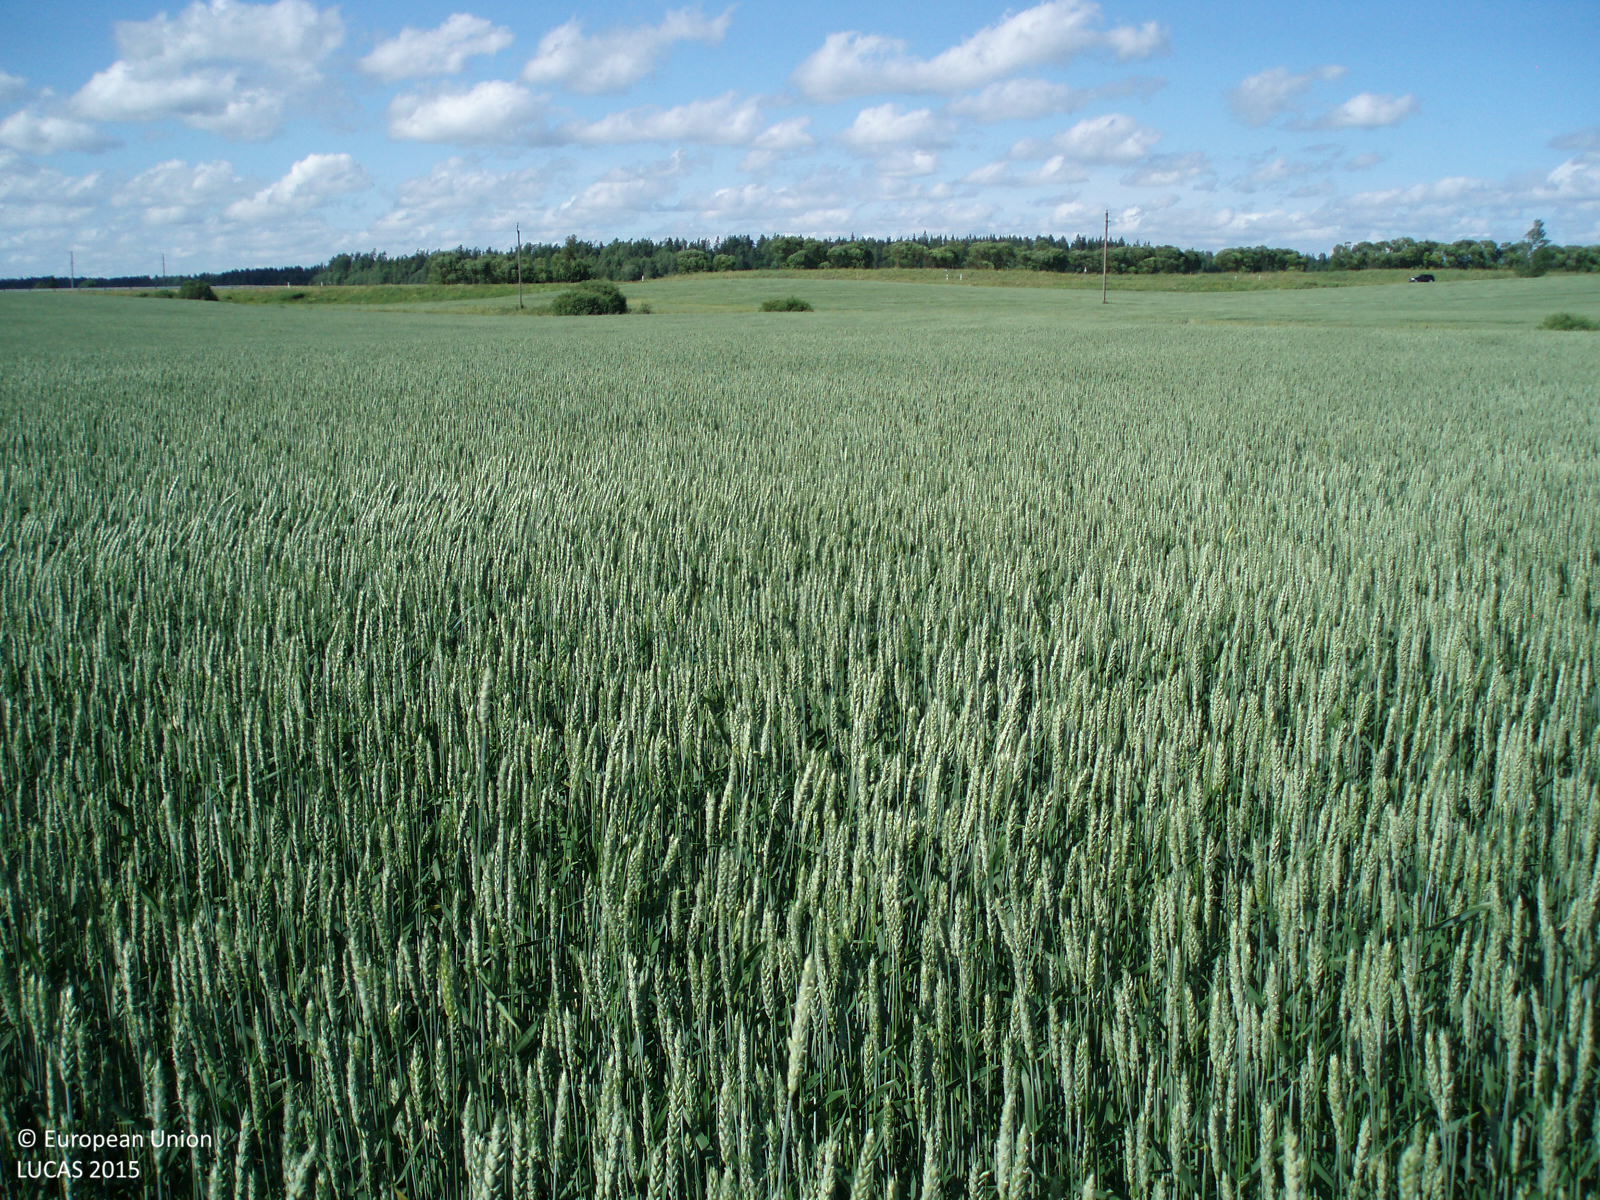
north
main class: Cropland
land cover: Common wheat
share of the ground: > 75 %
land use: Agriculture (excluding fallow land and kitchen gardens)
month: July
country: LT
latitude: 56.0003
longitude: 22.4208
